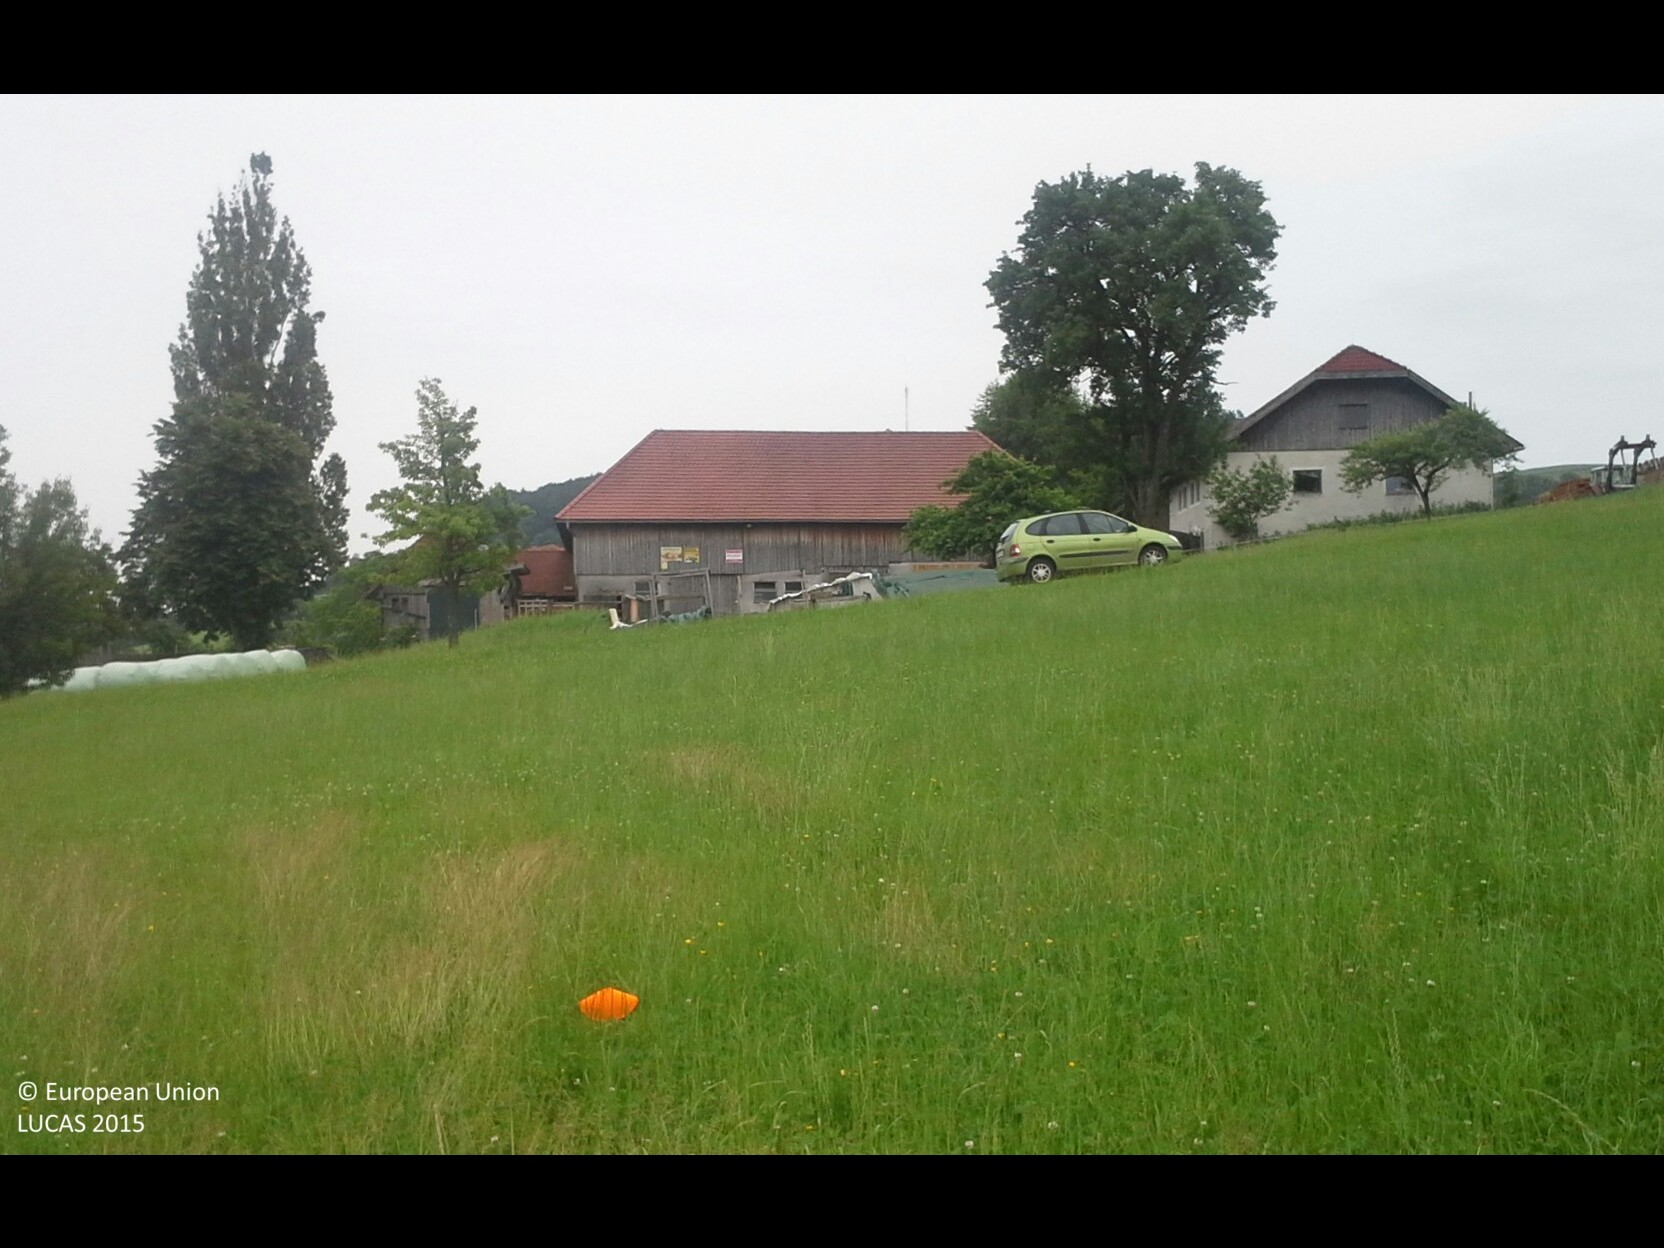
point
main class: Grassland
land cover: Grassland without tree/shrub cover
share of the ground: > 75 %
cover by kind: herbaceous plants 100 %
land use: Agriculture (excluding fallow land and kitchen gardens)
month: June
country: AT
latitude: 47.9944
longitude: 14.3283
